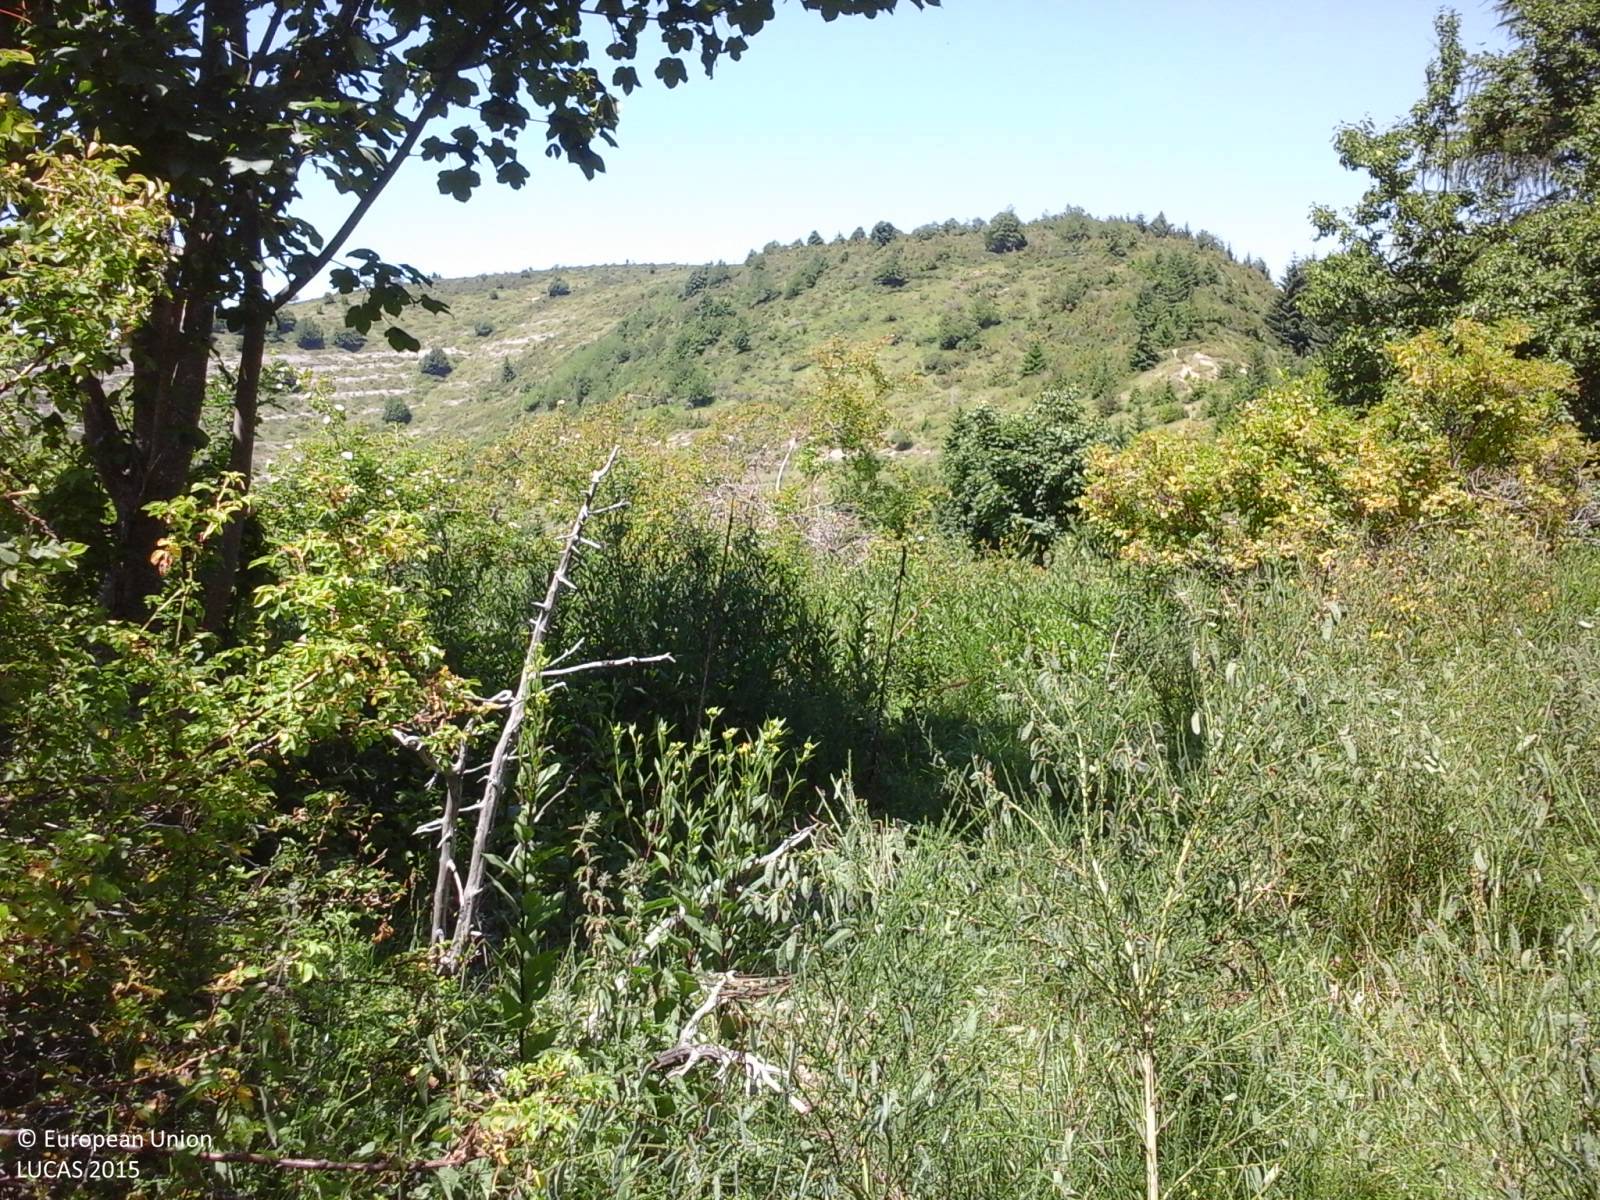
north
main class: Shrubland
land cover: Shrubland with sparse tree cover
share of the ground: > 75 %
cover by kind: shrubs 60 %, herbaceous plants 35 %, broadleaved forest trees 5 %
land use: Semi-natural and natural areas not in use
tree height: > 5 m
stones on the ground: < 10 %
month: July
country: IT
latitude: 42.5628
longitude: 13.3394
